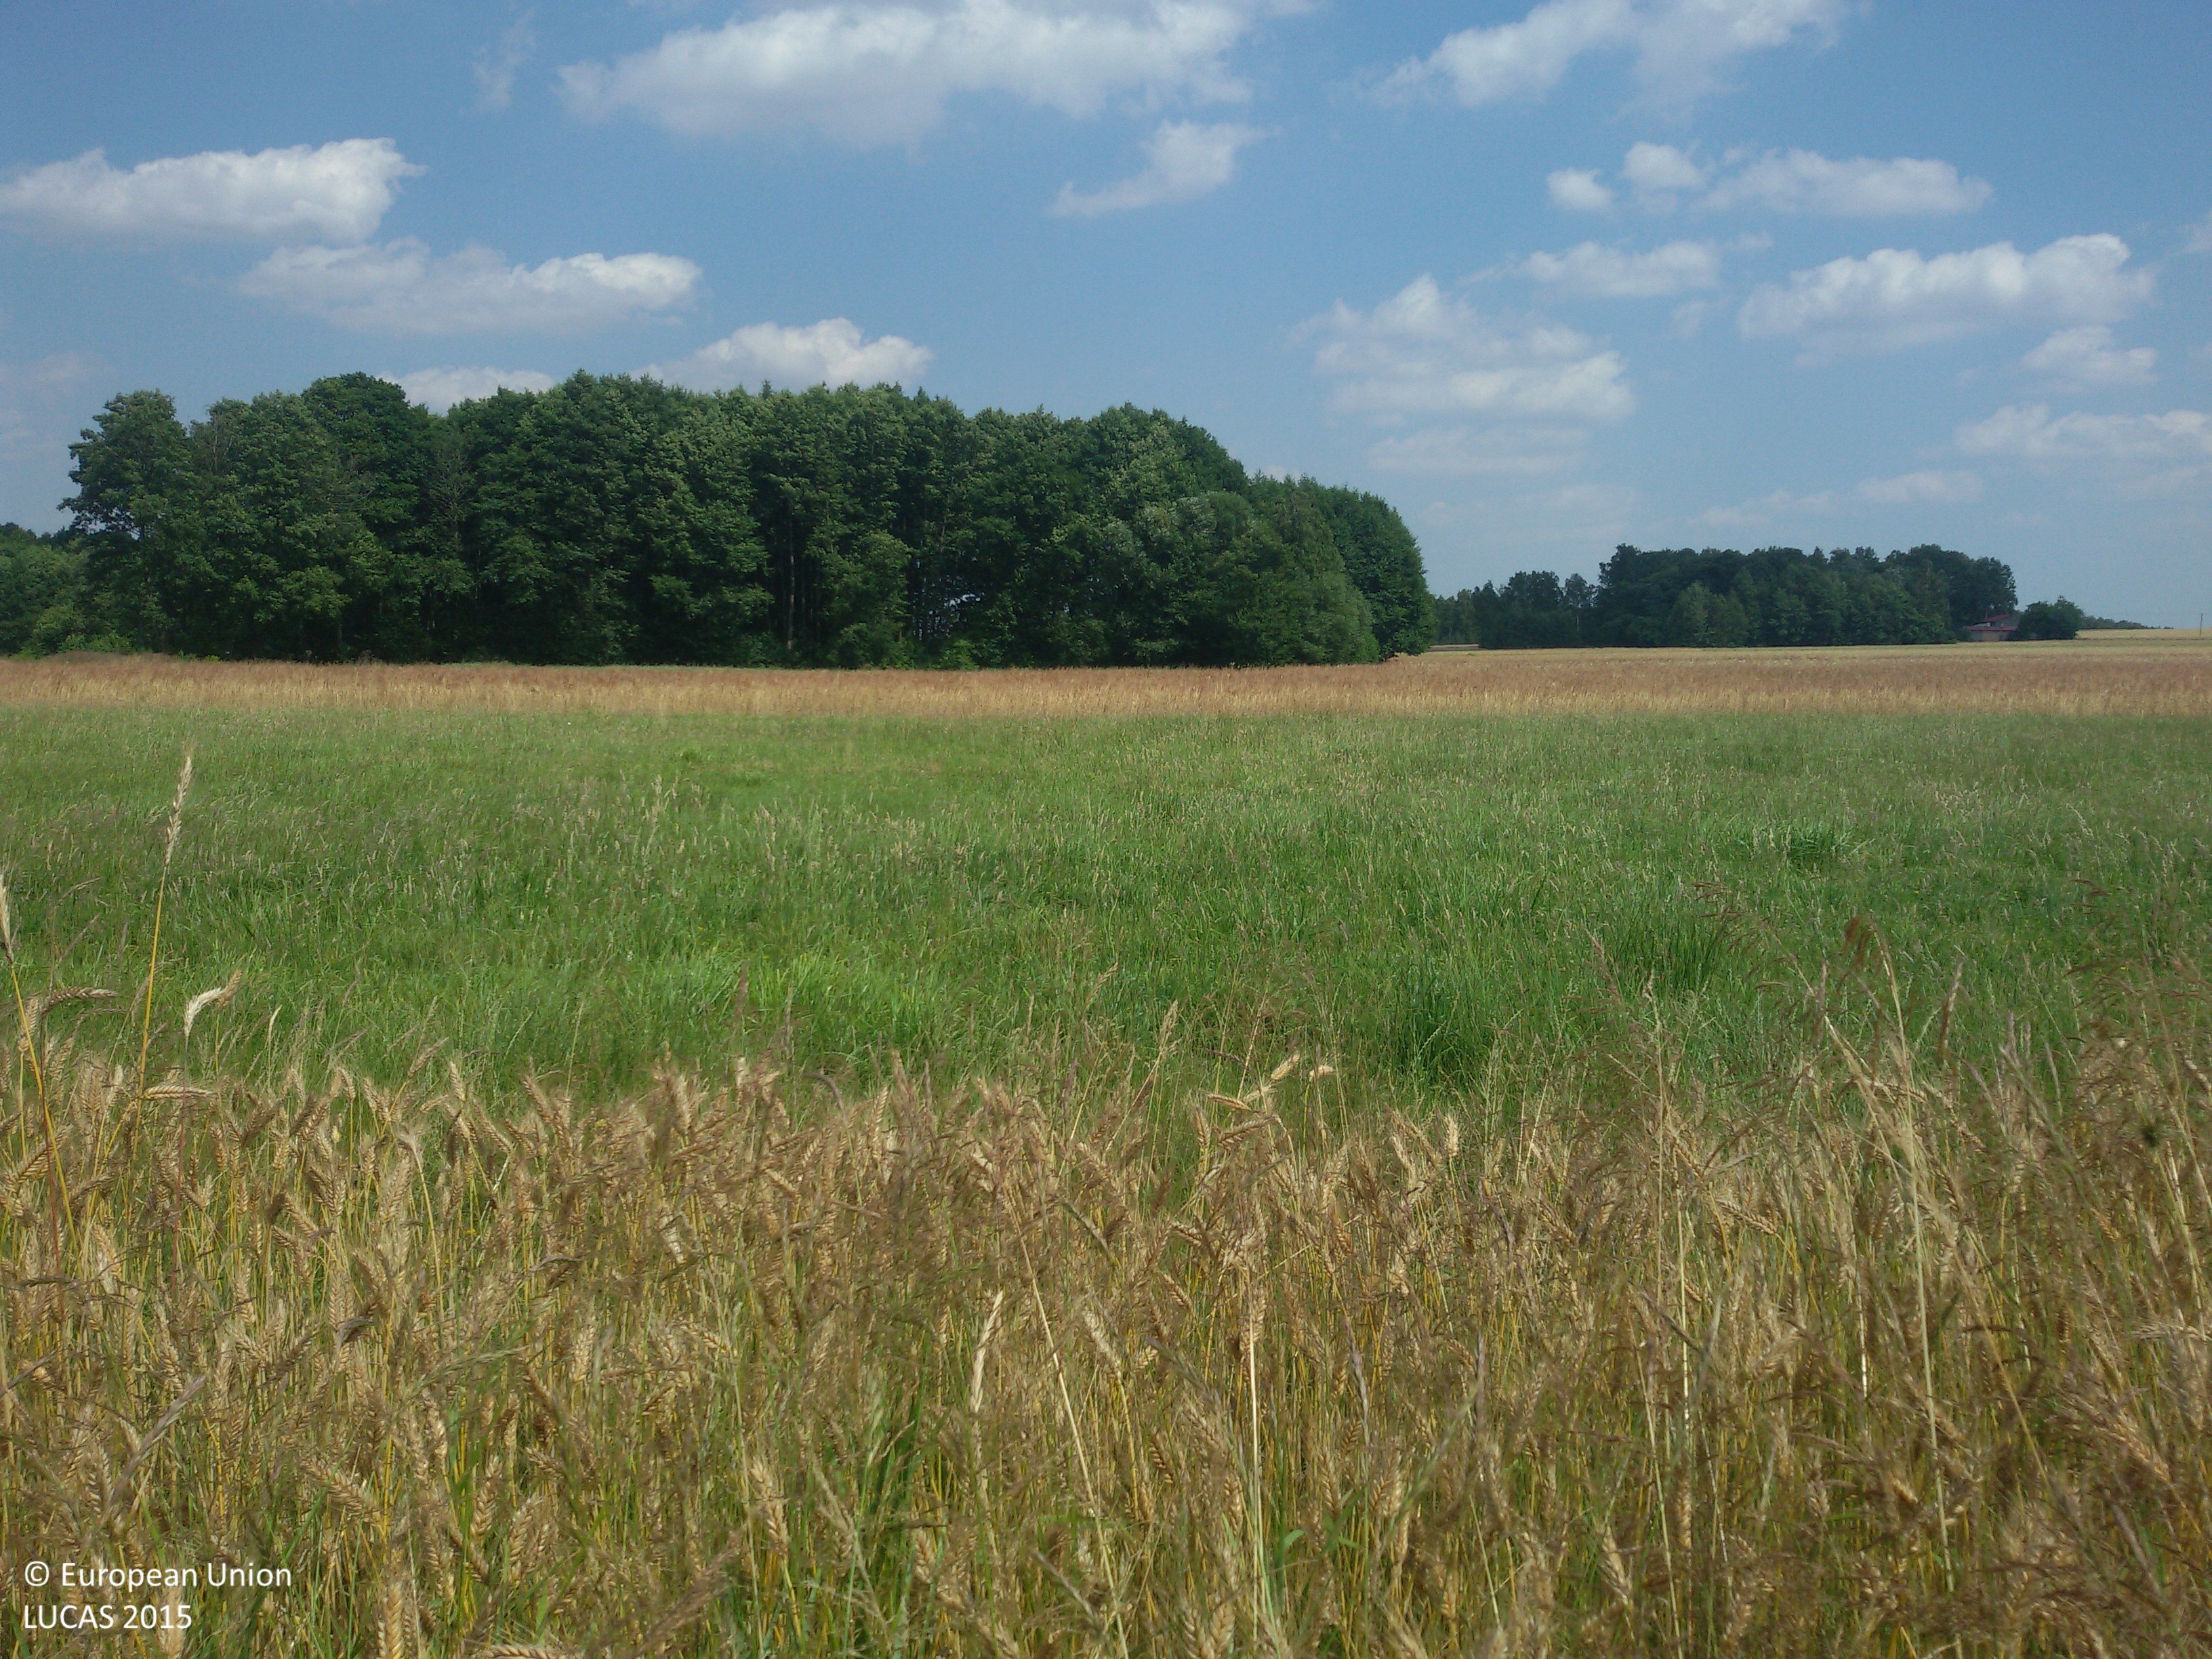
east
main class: Cropland
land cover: Triticale
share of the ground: > 75 %
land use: Agriculture (excluding fallow land and kitchen gardens)
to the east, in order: Triticale; Grass margins; Tracks; Grassland without tree/shrub cover; Triticale; Grass margins; Tracks; Grass margins; Oats; Ditches and canals; Triticale; Broadleaved woodland; Triticale
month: July
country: PL
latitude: 51.7909
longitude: 19.7879
